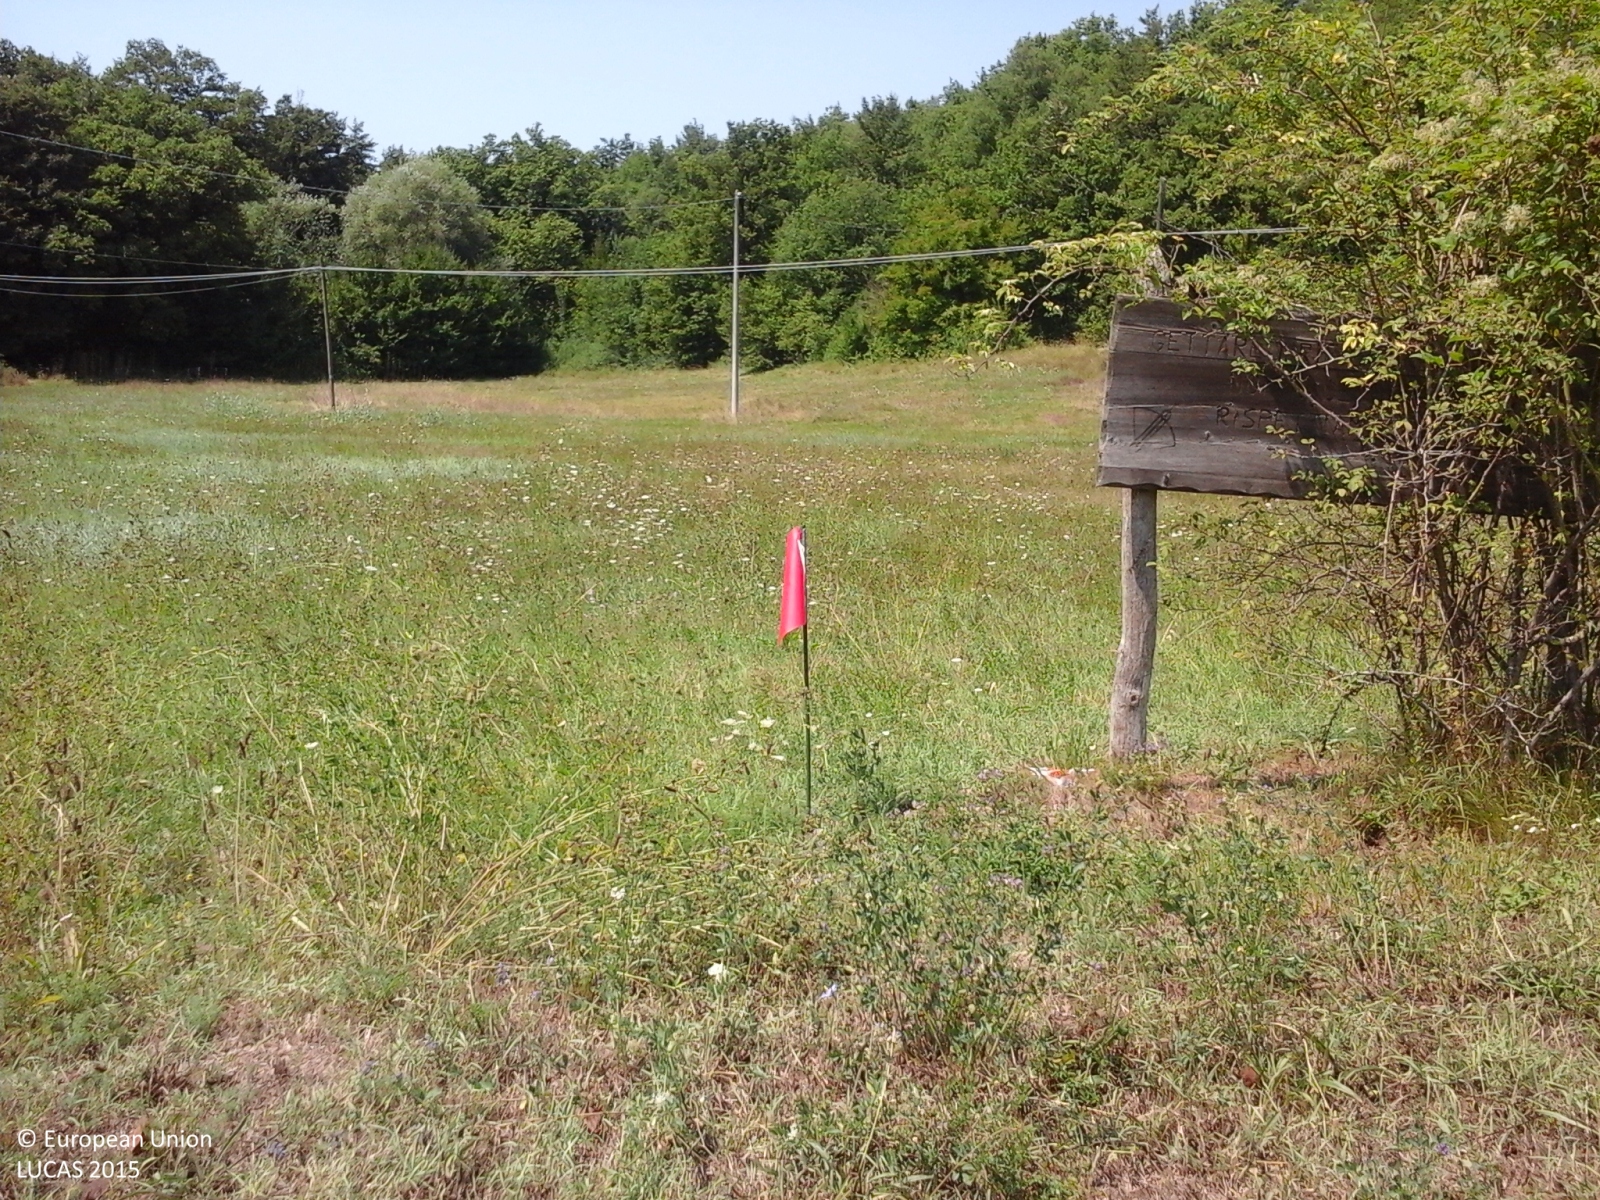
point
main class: Grassland
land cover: Grassland without tree/shrub cover
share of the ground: > 75 %
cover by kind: herbaceous plants 100 %
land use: Agriculture (excluding fallow land and kitchen gardens)
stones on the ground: < 10 %
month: August
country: IT
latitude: 43.7106
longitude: 12.3397
